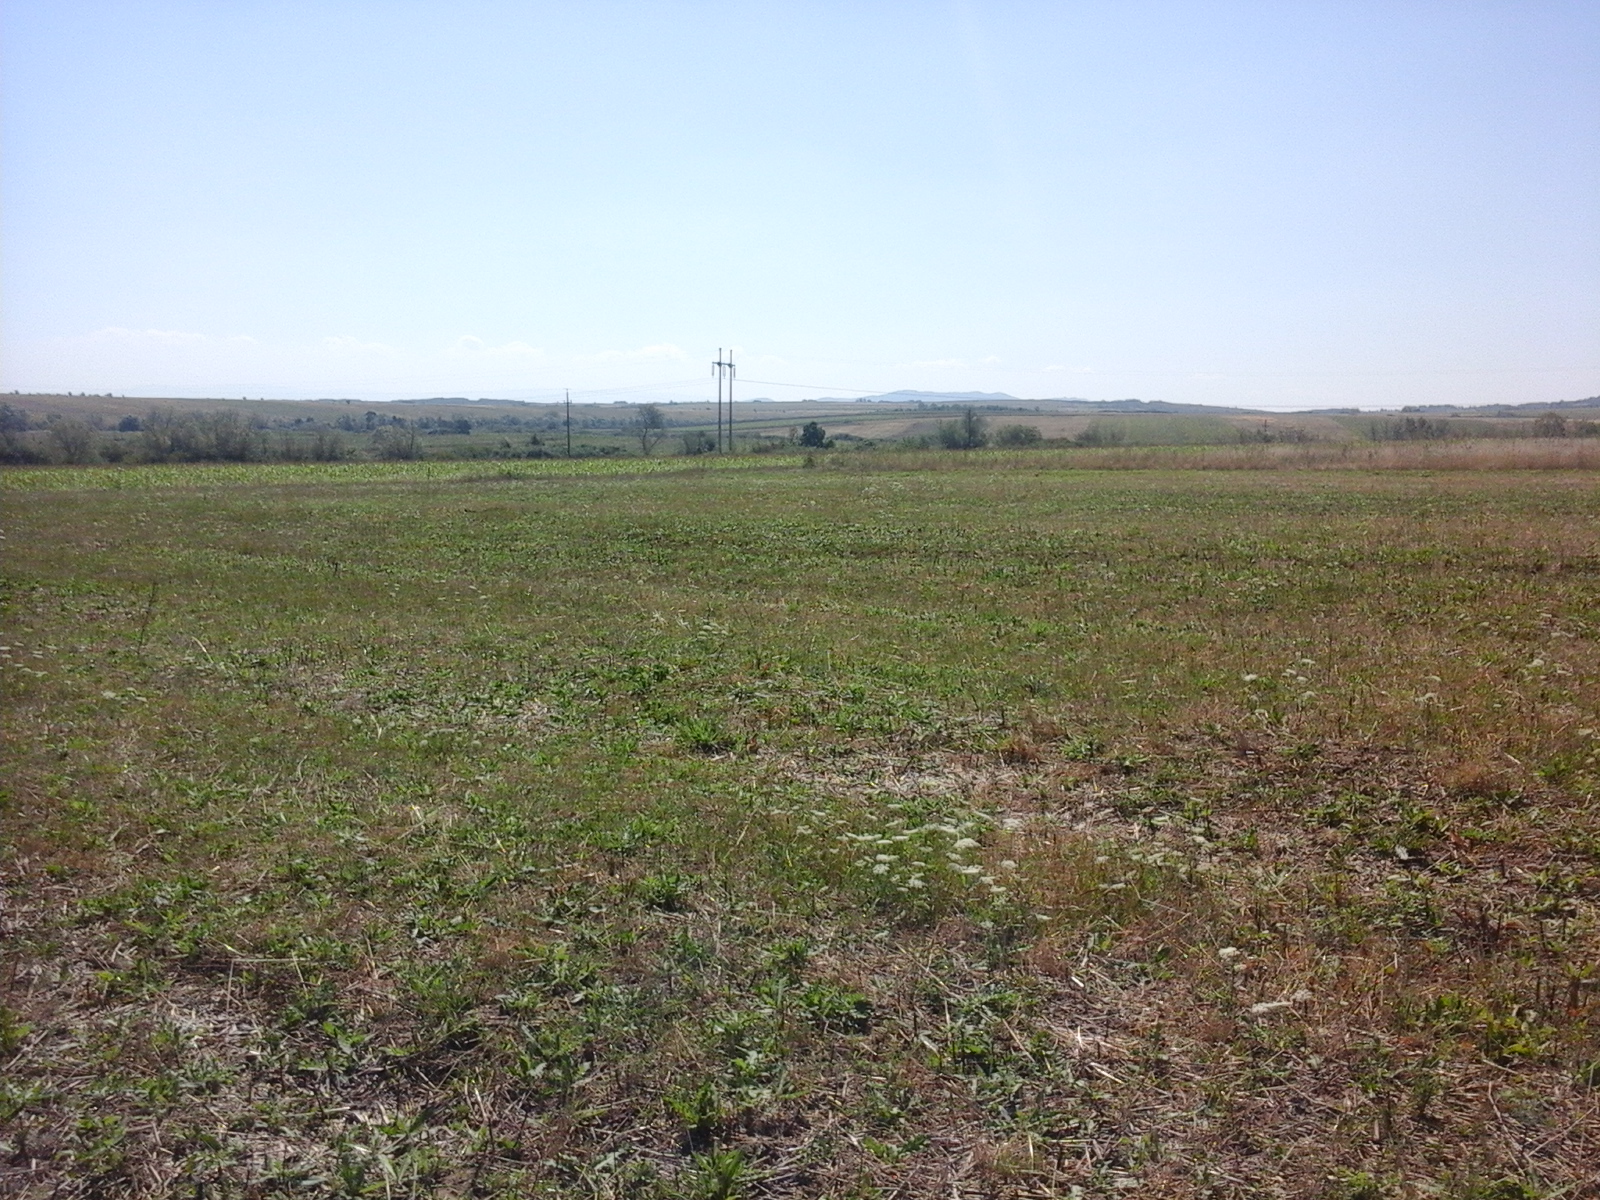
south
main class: Cropland
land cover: Common wheat
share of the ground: 25 - 50 %
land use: Agriculture (excluding fallow land and kitchen gardens)
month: August
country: RO
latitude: 45.6109
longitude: 21.7431
